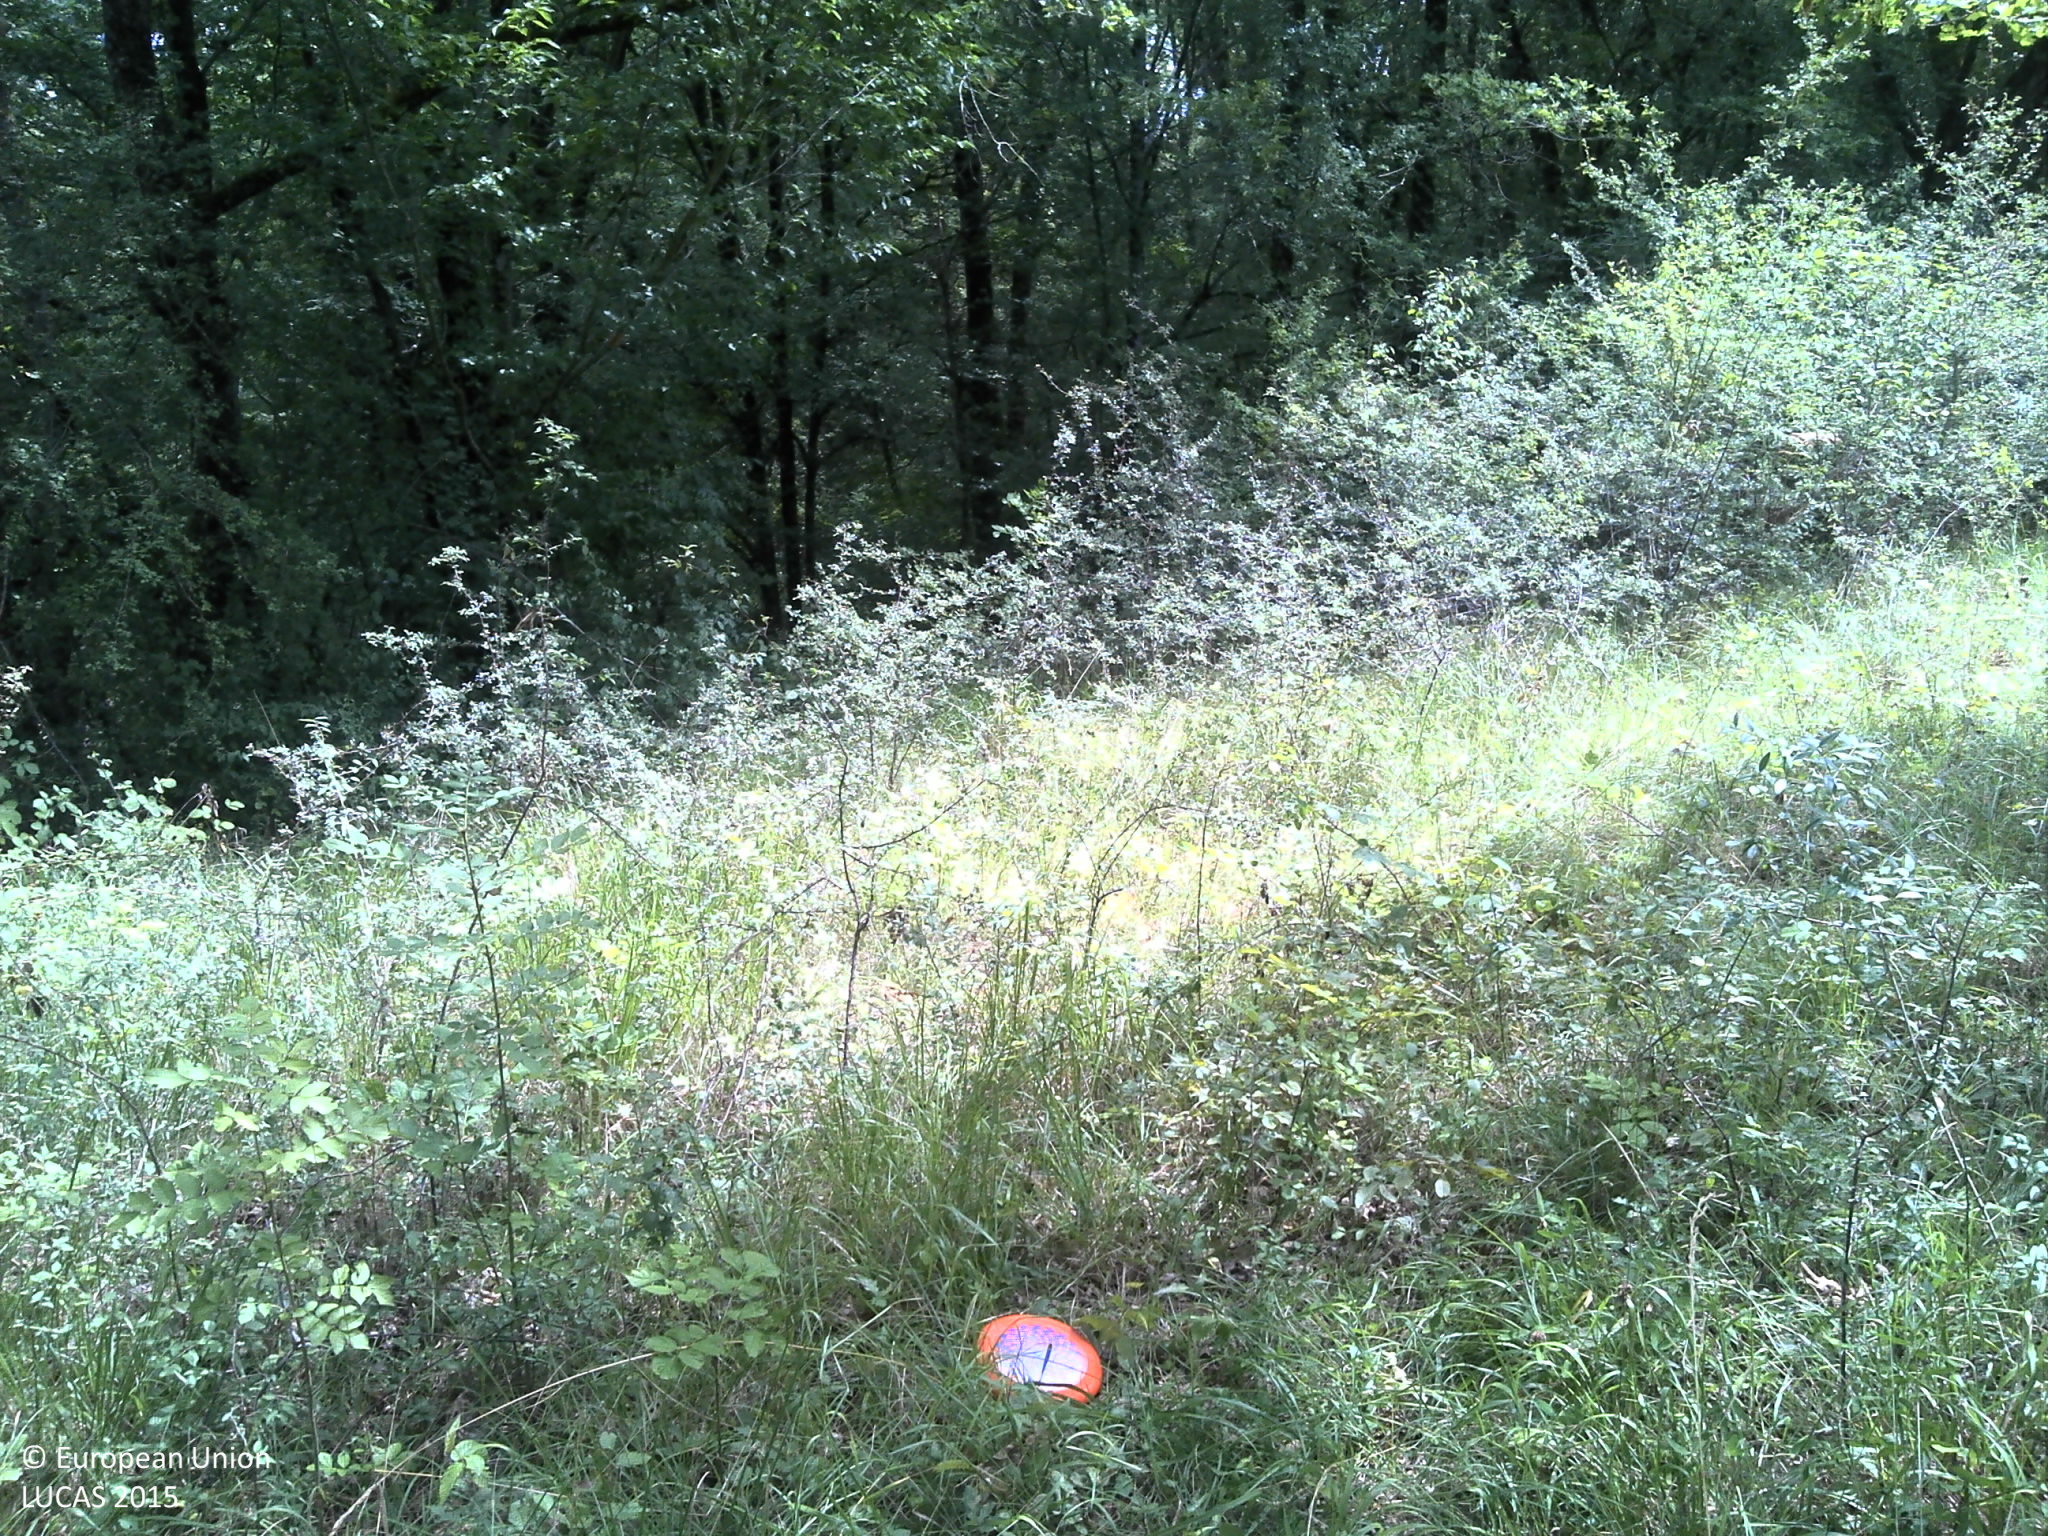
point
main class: Woodland
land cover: Broadleaved woodland
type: mesophytic deciduous forest
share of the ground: 50 - 75 %
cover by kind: broadleaved forest trees 55 %, herbaceous plants 35 %, shrubs 5 %, lichens and mosses 5 %
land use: Forestry
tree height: > 5 m
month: July
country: FR
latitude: 44.9474
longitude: 1.7719
